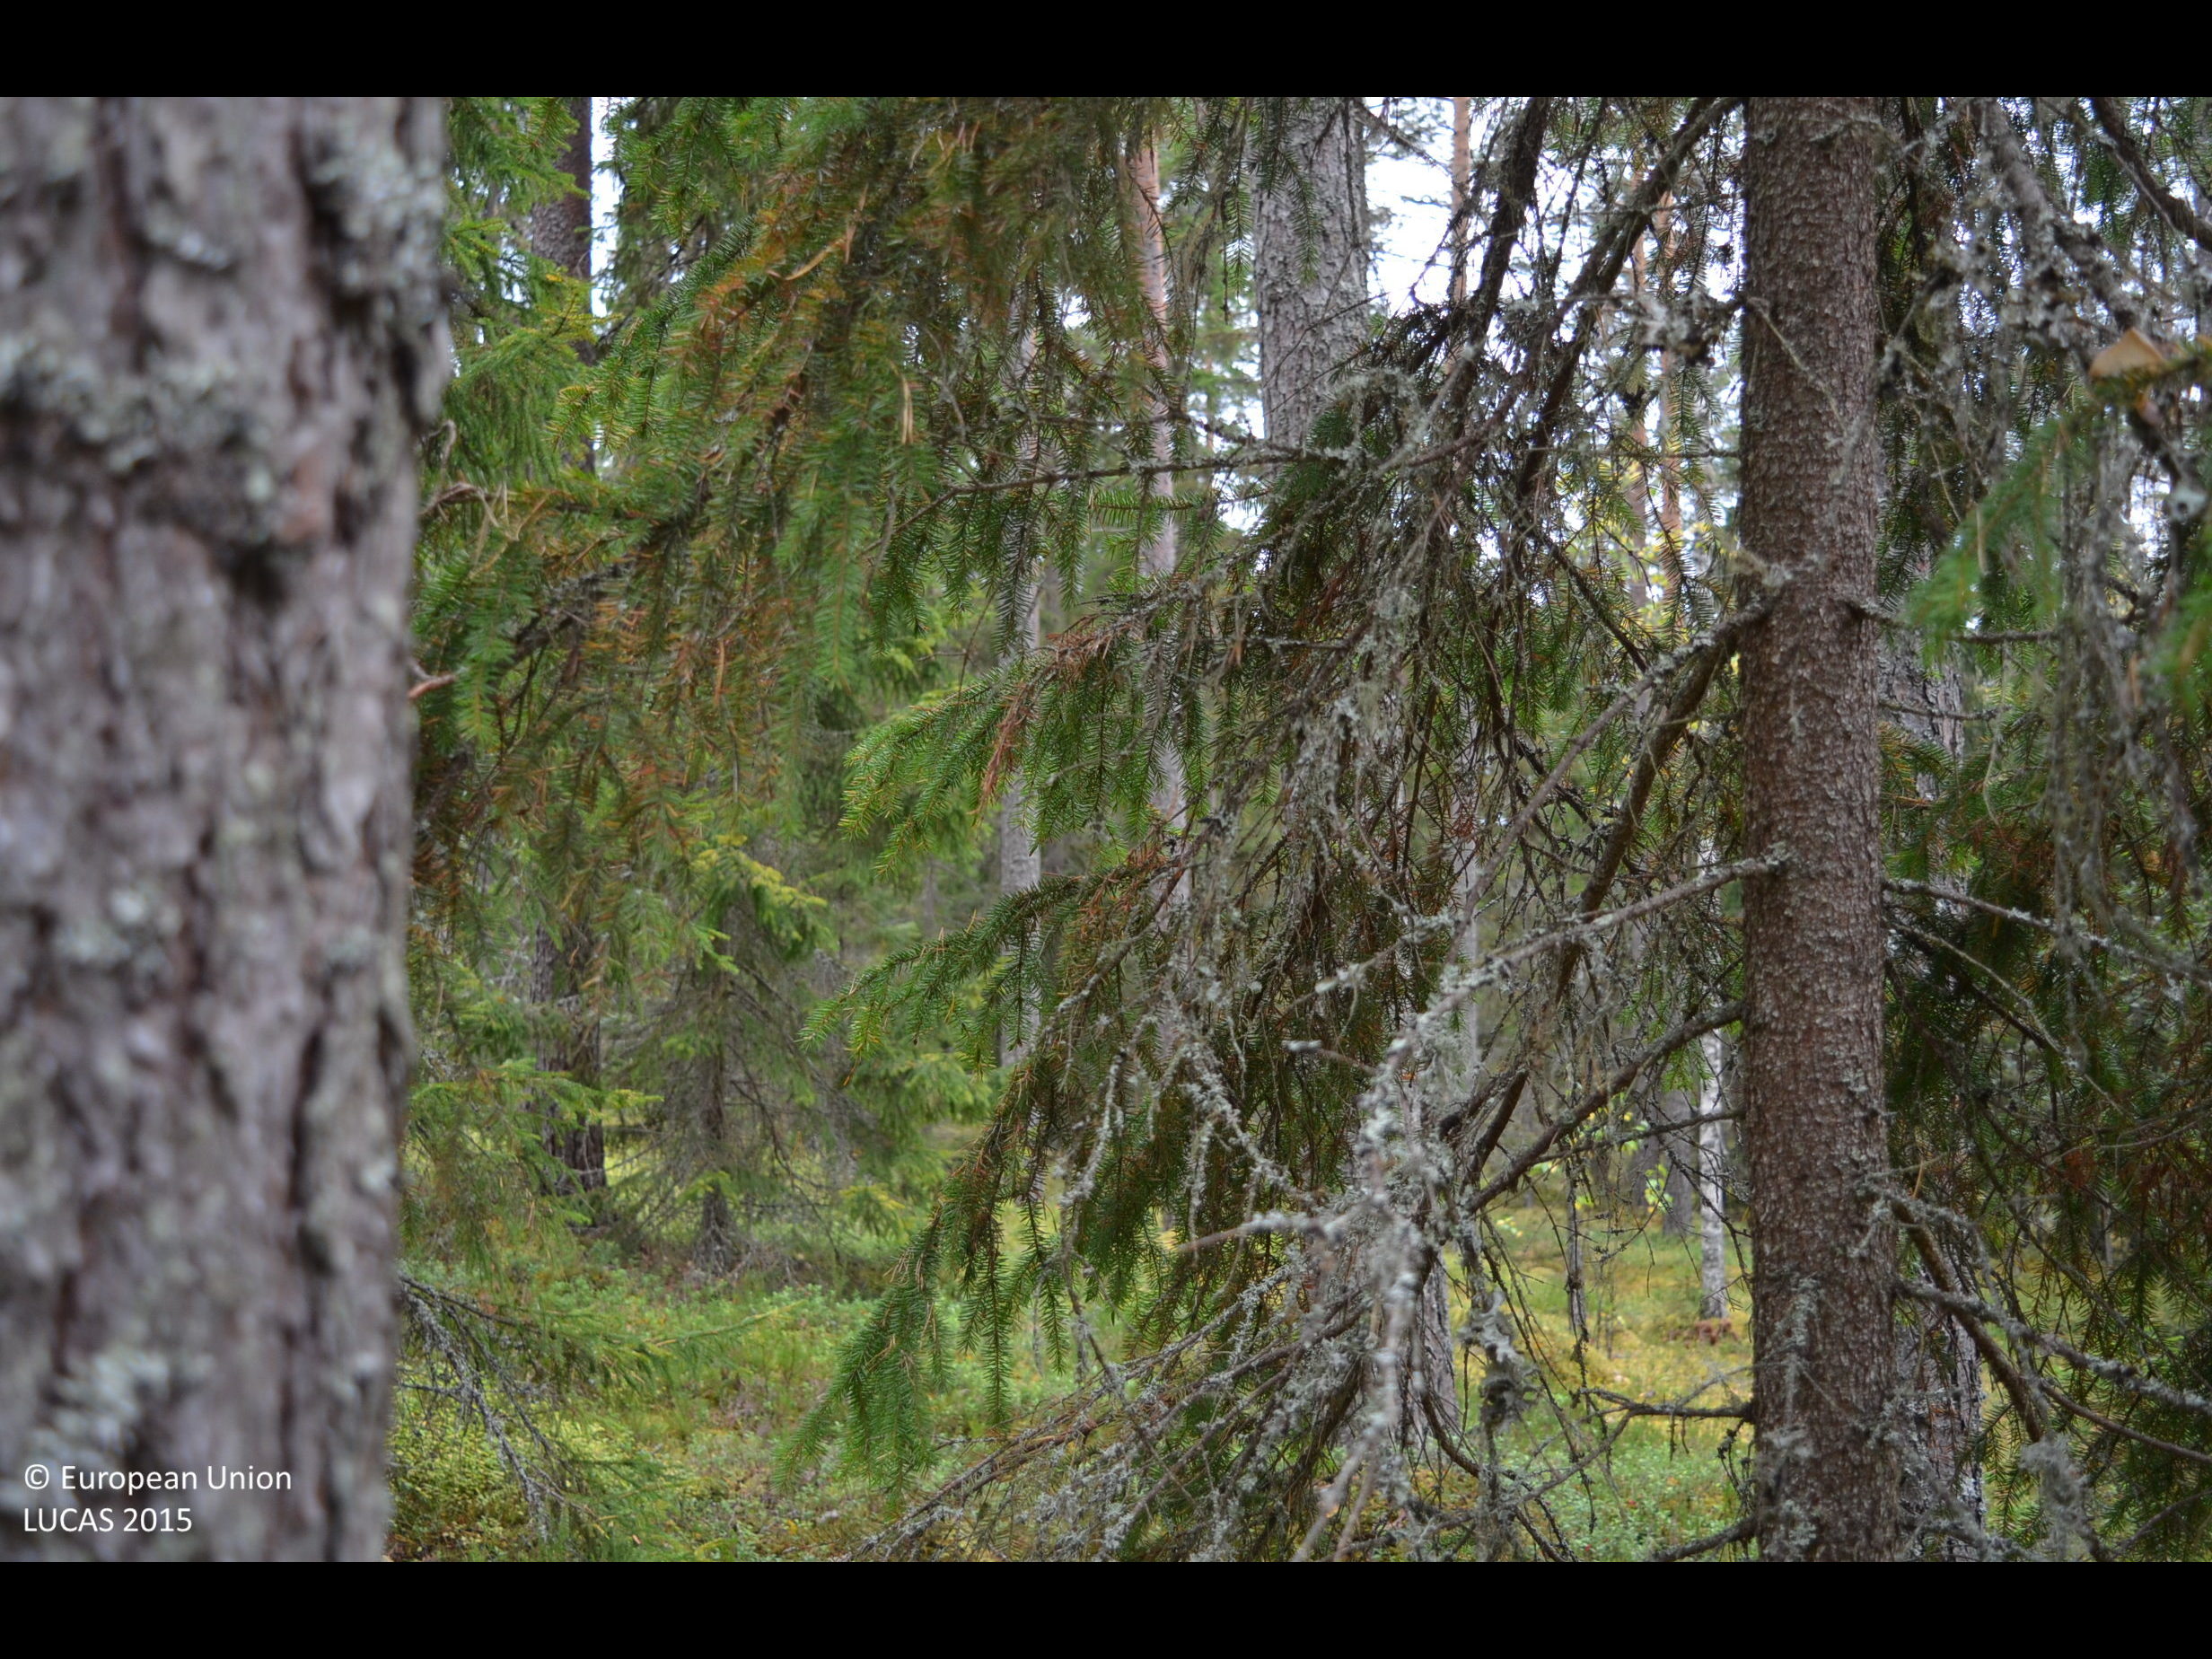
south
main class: Woodland
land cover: Other coniferous woodland
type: boreal forest
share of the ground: 50 - 75 %
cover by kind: coniferous forest trees 70 %, shrubs 15 %, lichens and mosses 15 %
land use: Forestry
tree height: > 5 m
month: September
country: FI
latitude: 62.8537
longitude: 23.8054
